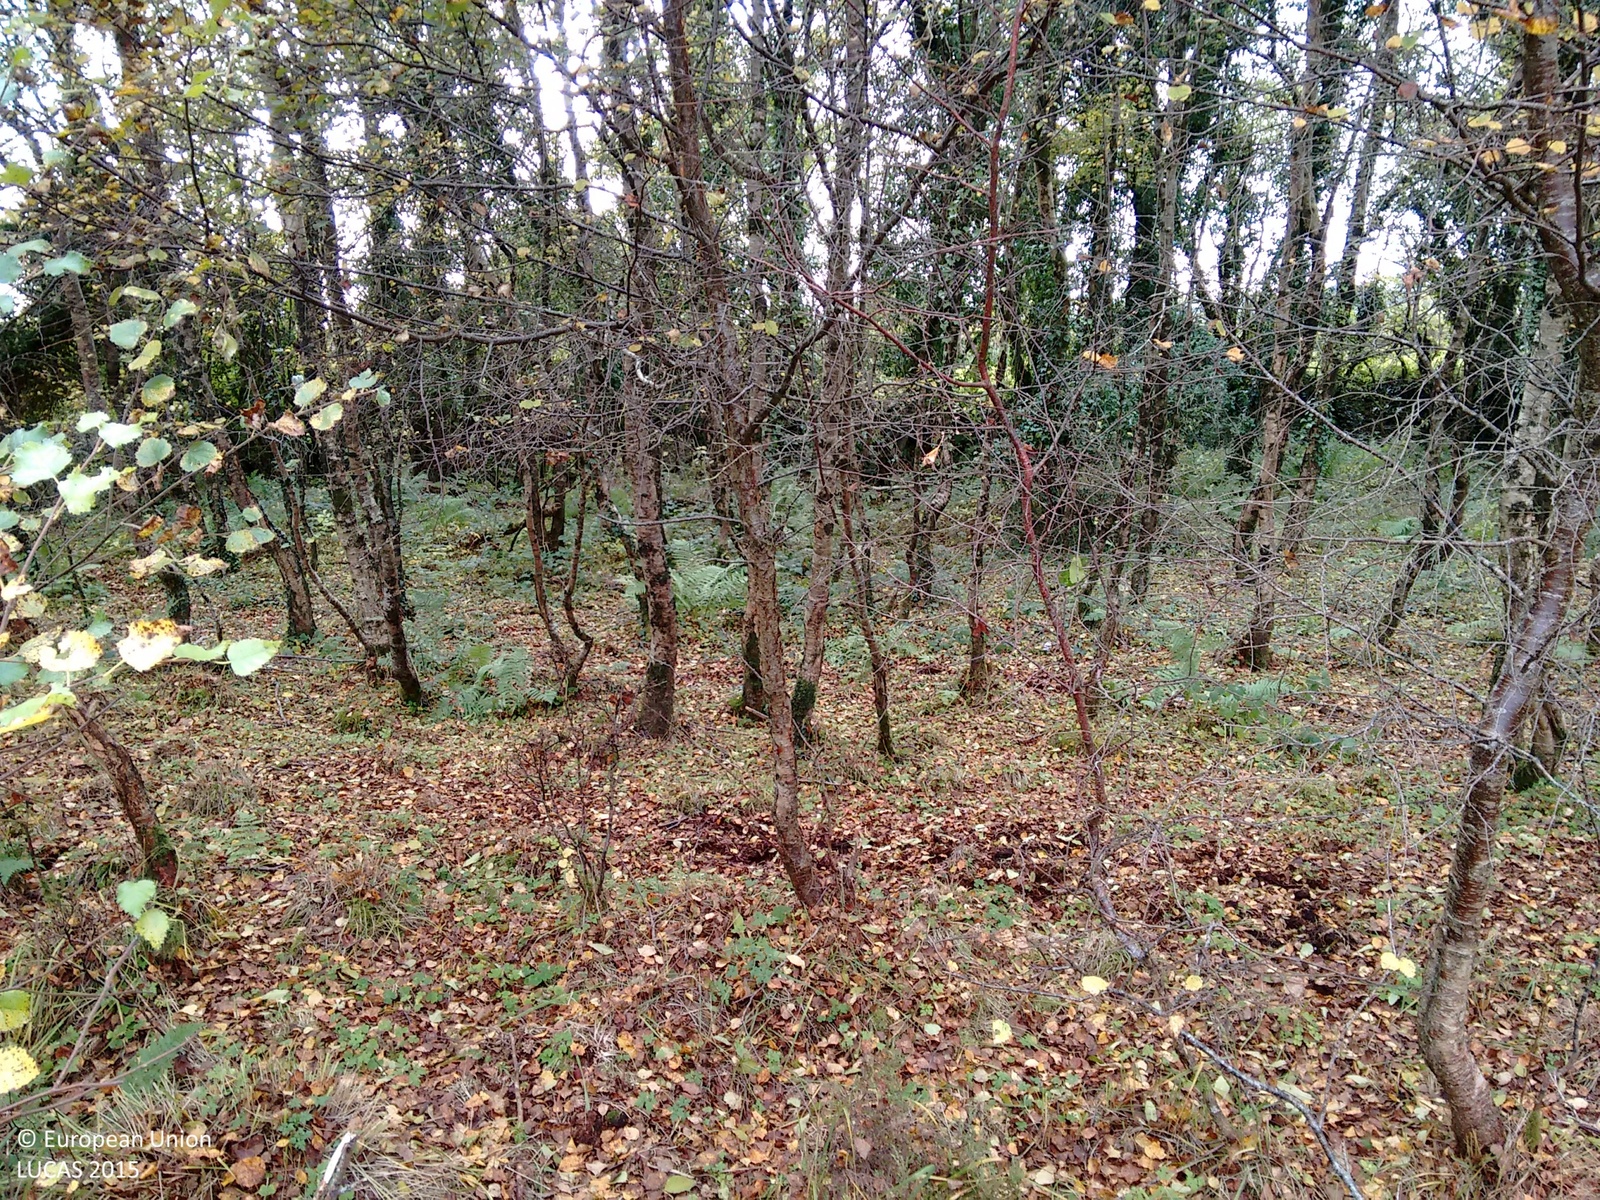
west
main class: Woodland
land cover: Broadleaved woodland
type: acidophilous oak and oak-birch forest
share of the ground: > 75 %
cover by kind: broadleaved forest trees 100 %
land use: Semi-natural and natural areas not in use
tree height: > 5 m
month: October
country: GB
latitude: 54.3571
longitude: -7.4026
